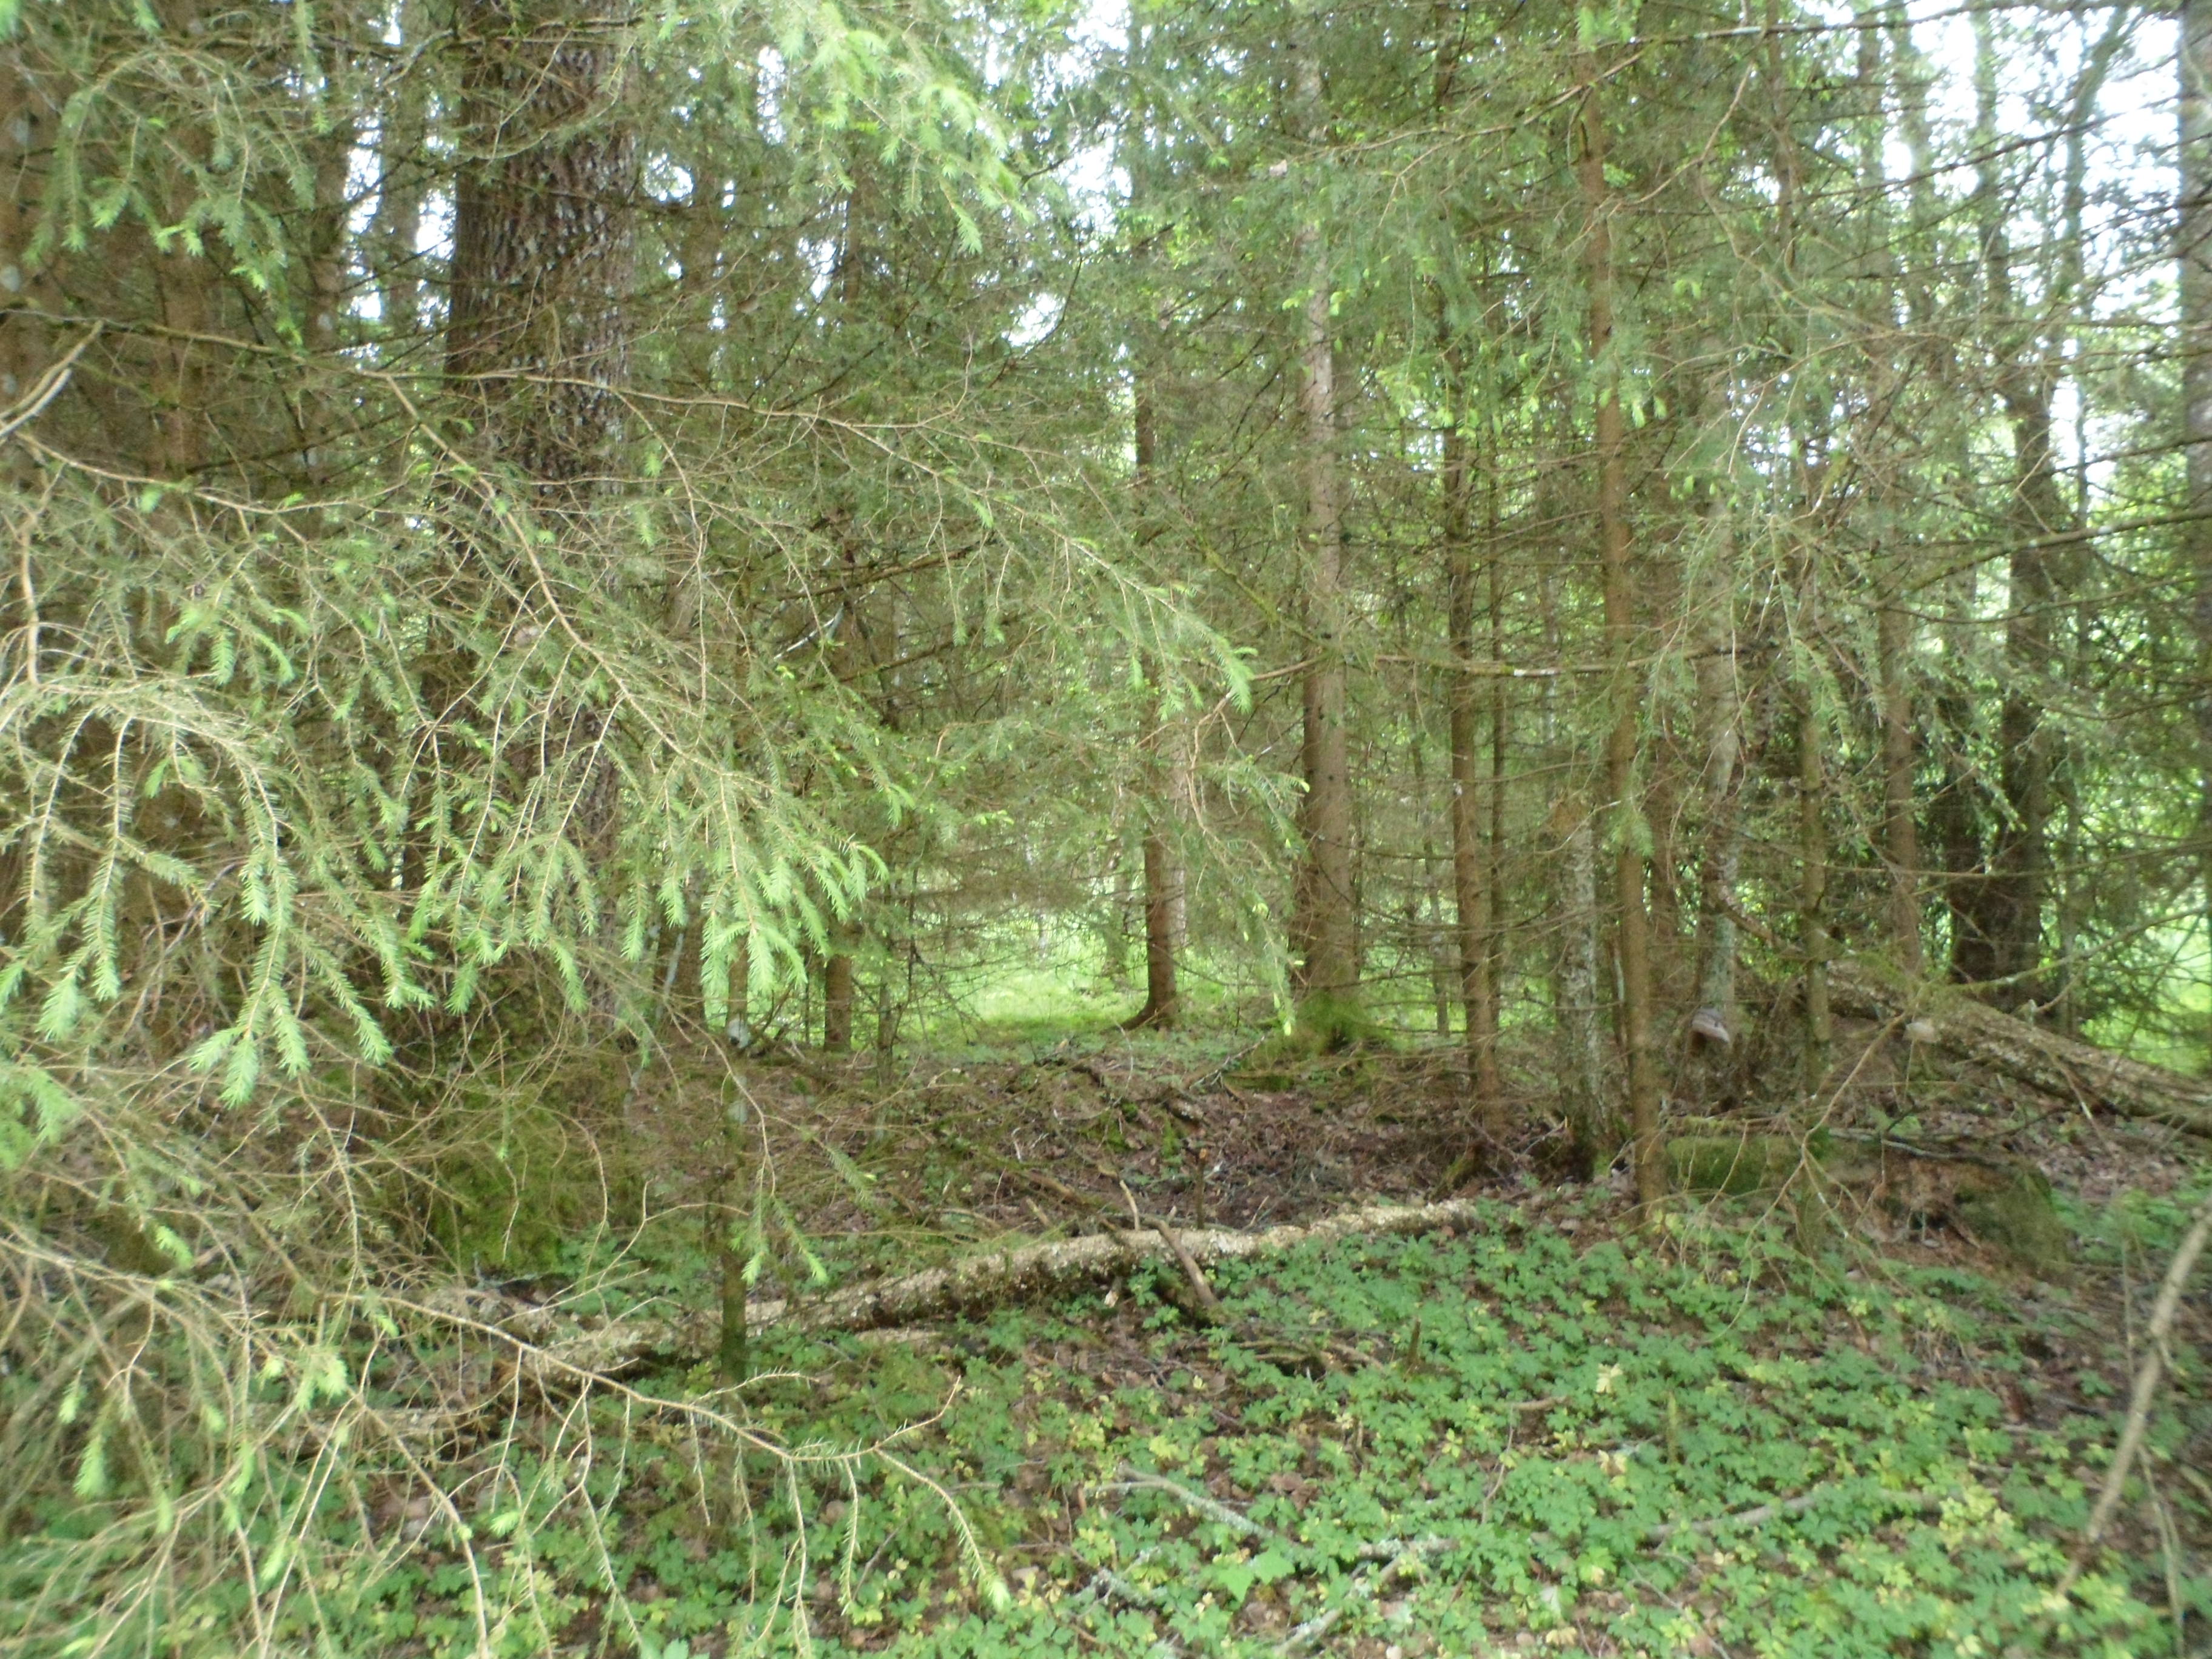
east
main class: Woodland
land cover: Spruce dominated mixed woodland
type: boreal forest
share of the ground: 50 - 75 %
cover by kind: broadleaved forest trees 45 %, coniferous forest trees 30 %, herbaceous plants 15 %, shrubs 5 %, lichens and mosses 5 %
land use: Forestry
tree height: > 5 m
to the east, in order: Spruce dominated mixed woodland; Tracks; Spruce dominated mixed woodland; Dry stone walls; Barley; Fences; Broadleaved woodland
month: June
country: SE
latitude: 56.9547
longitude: 14.5184
